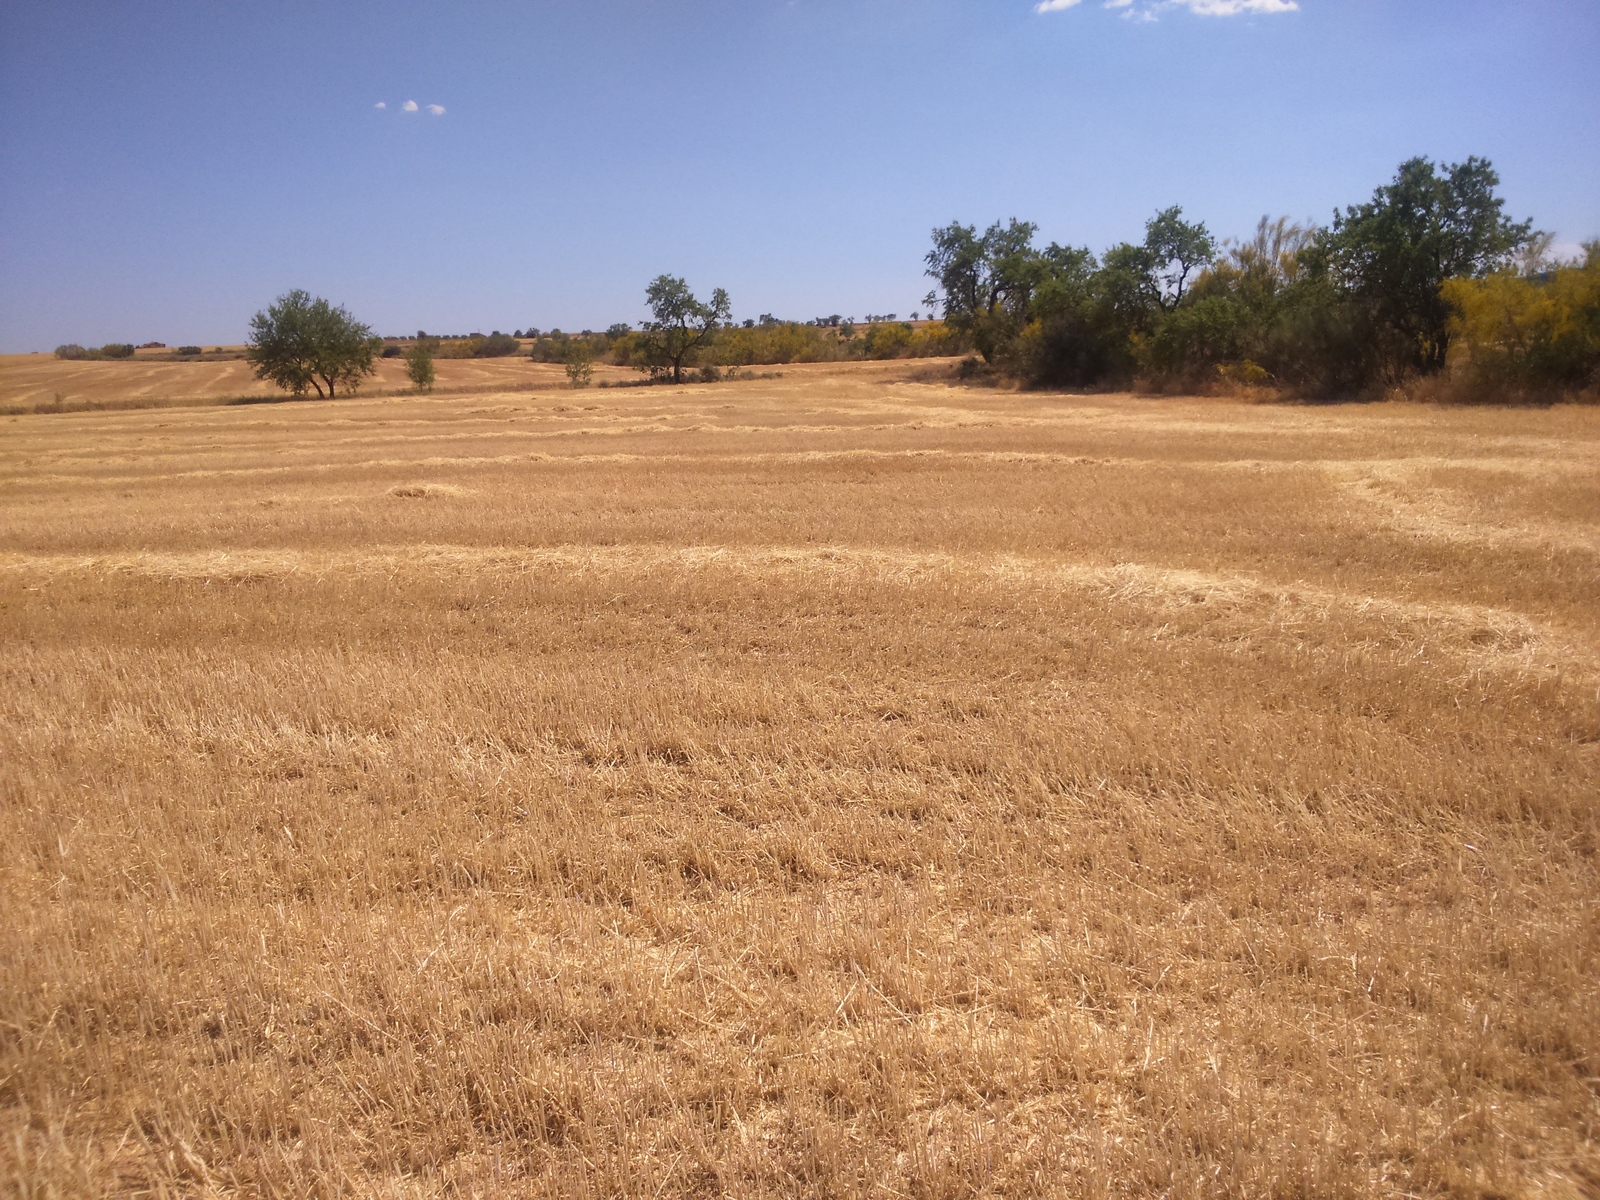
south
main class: Cropland
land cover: Barley
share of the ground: < 10 %
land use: Agriculture (excluding fallow land and kitchen gardens)
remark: Harvested field
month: June
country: ES
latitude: 41.6004
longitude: 0.0626
